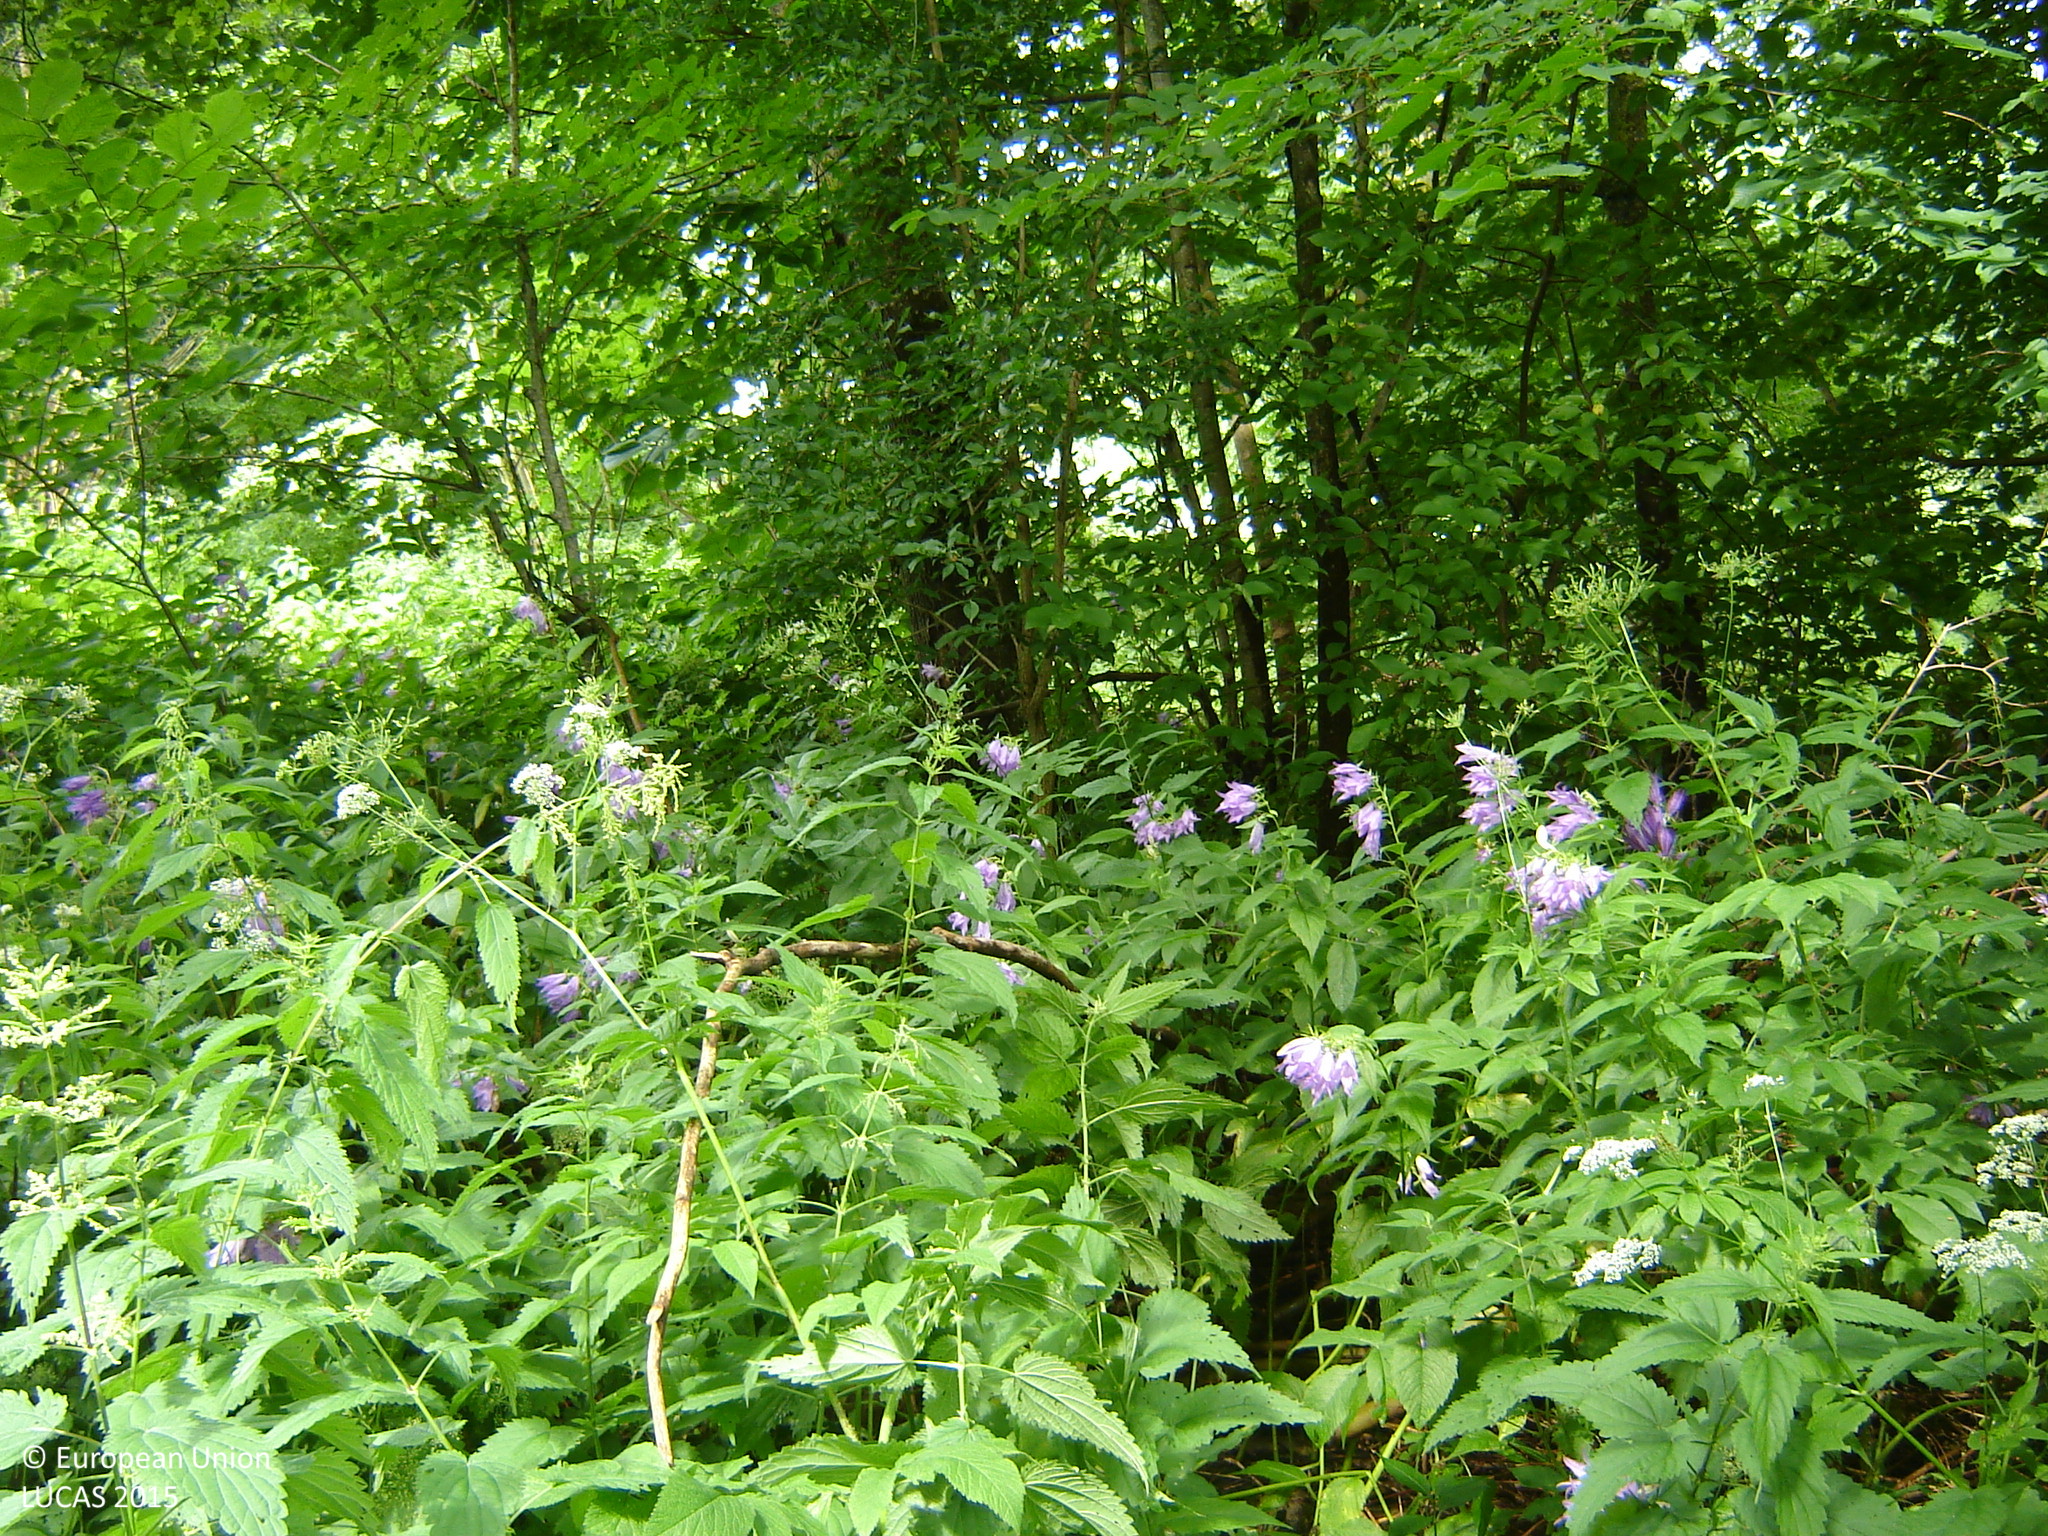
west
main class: Woodland
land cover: Broadleaved woodland
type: floodplain forest
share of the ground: > 75 %
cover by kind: broadleaved forest trees 75 %, herbaceous plants 25 %
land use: Forestry
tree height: > 5 m
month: July
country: LT
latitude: 55.3680
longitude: 25.1847
